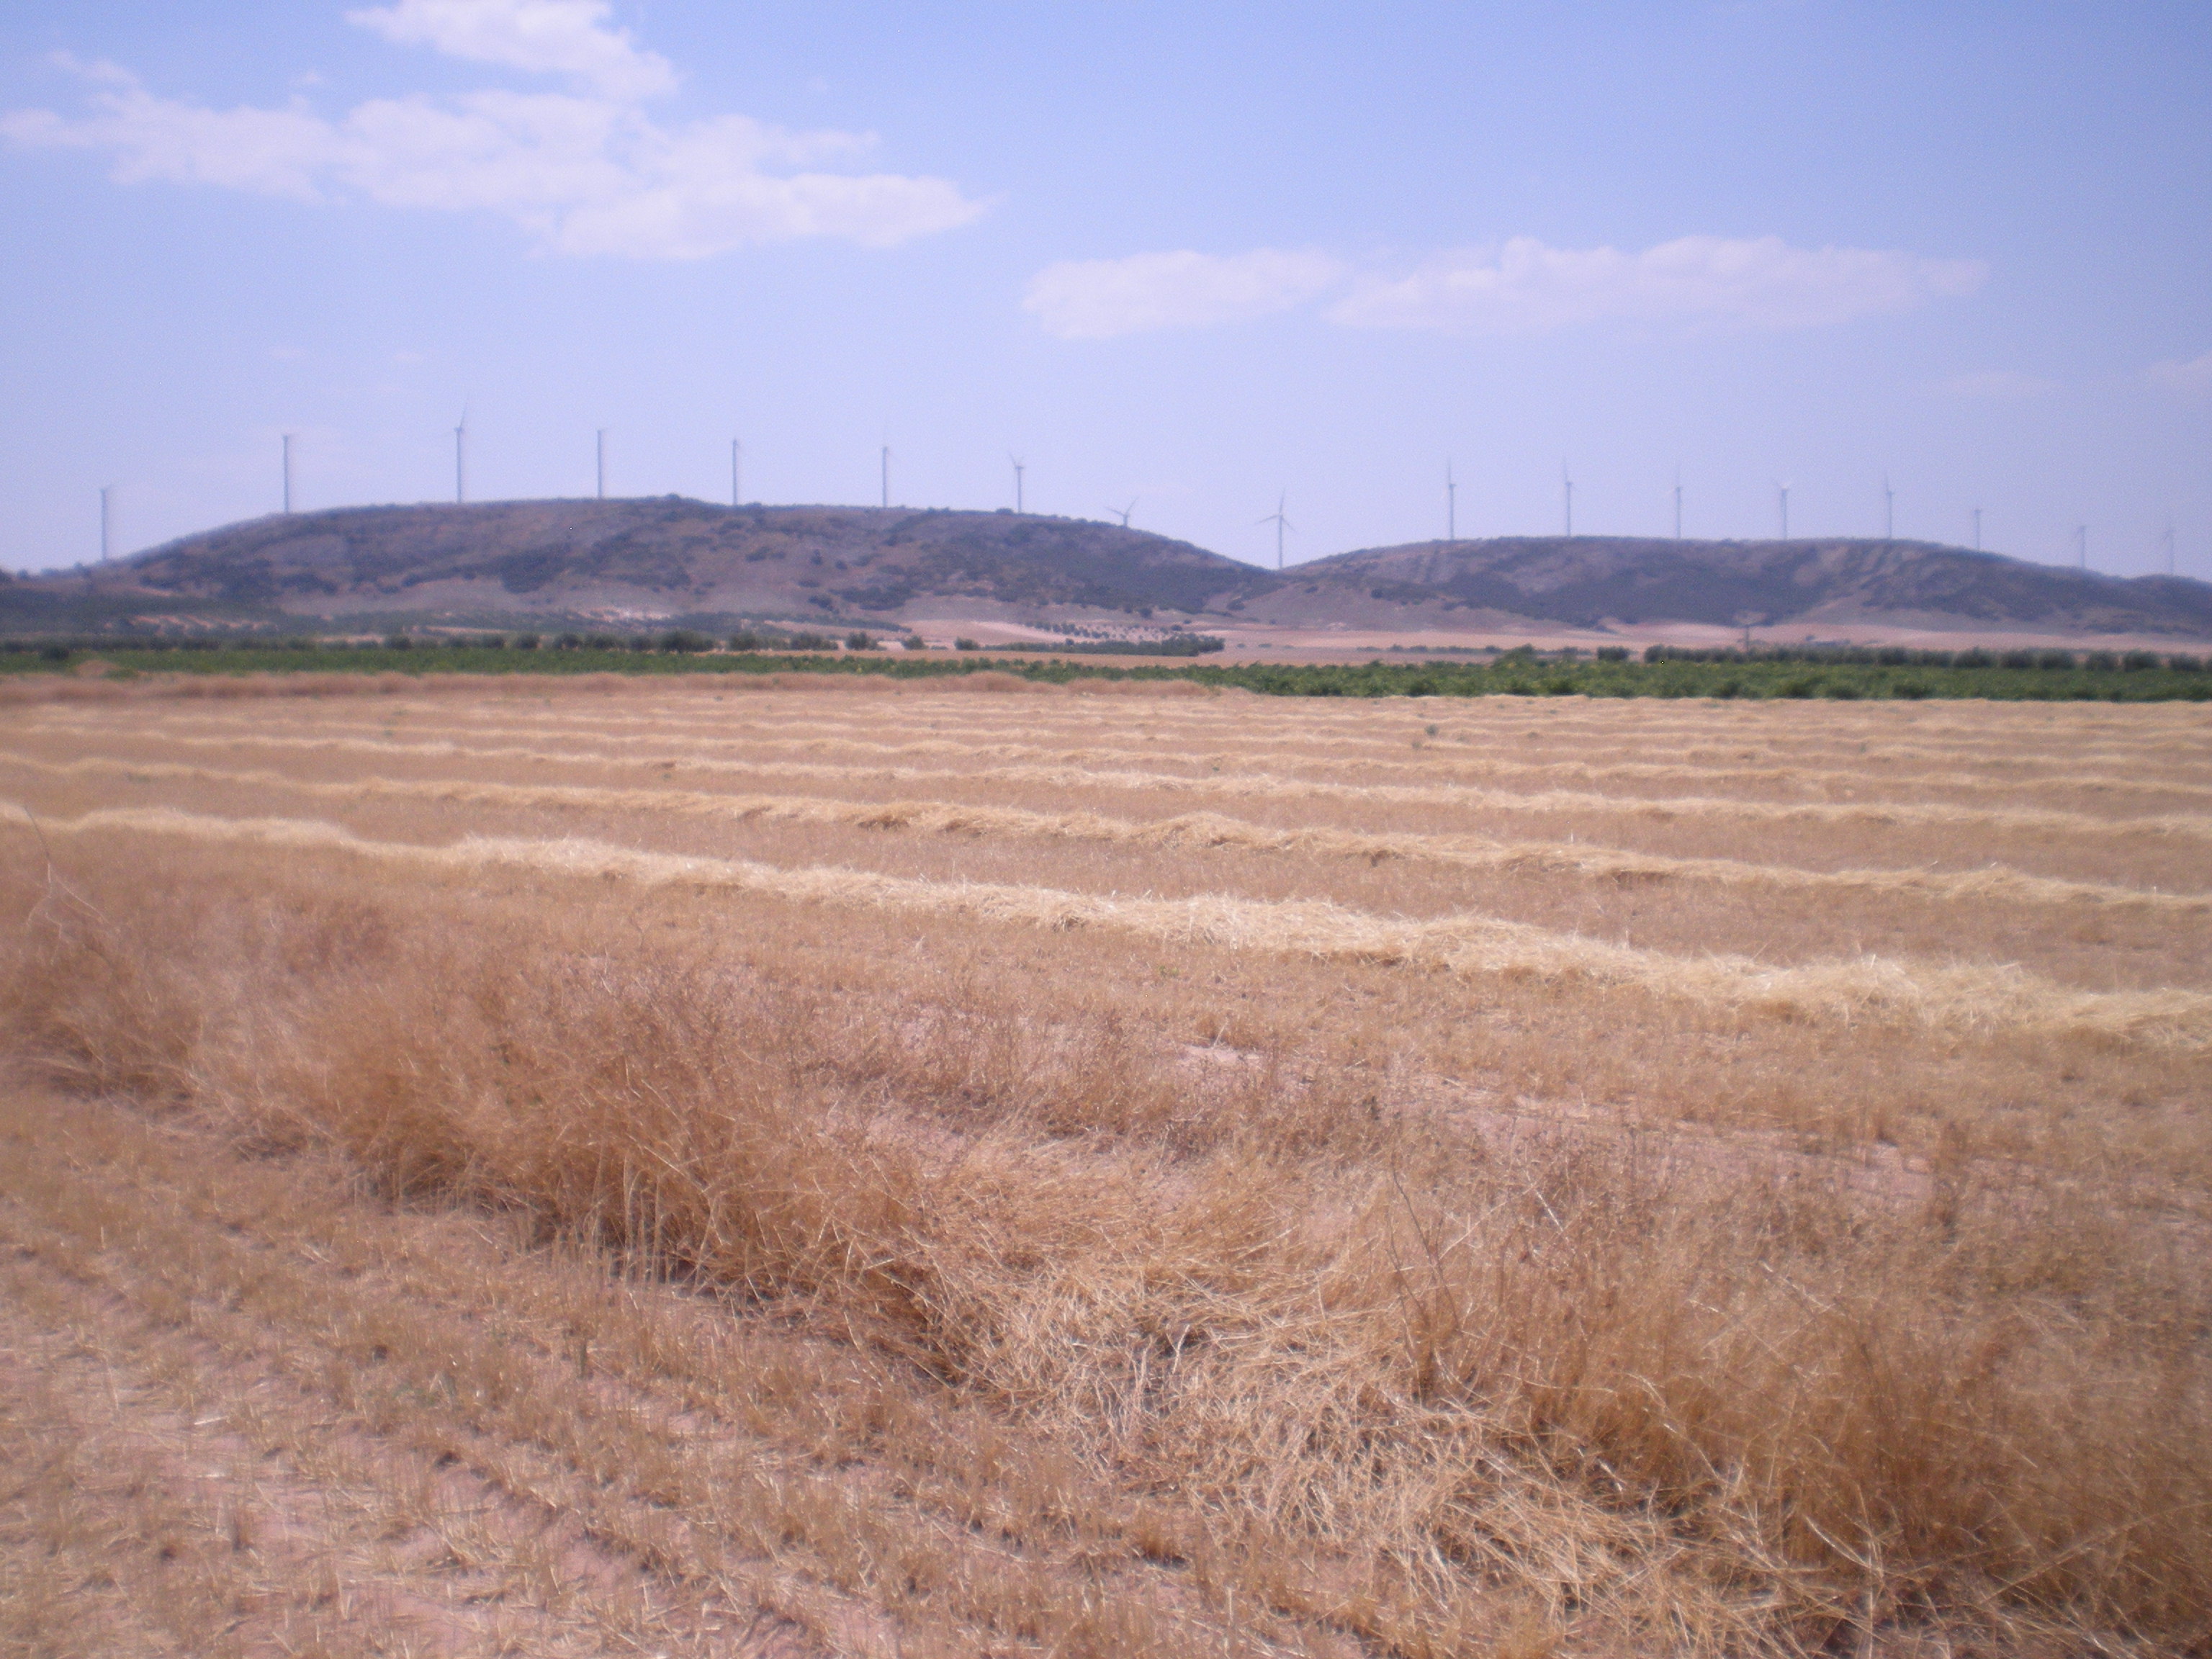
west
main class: Cropland
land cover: Barley
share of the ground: < 10 %
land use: Agriculture (excluding fallow land and kitchen gardens)
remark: Harvested field
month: June
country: ES
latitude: 39.6592
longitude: -3.3689
